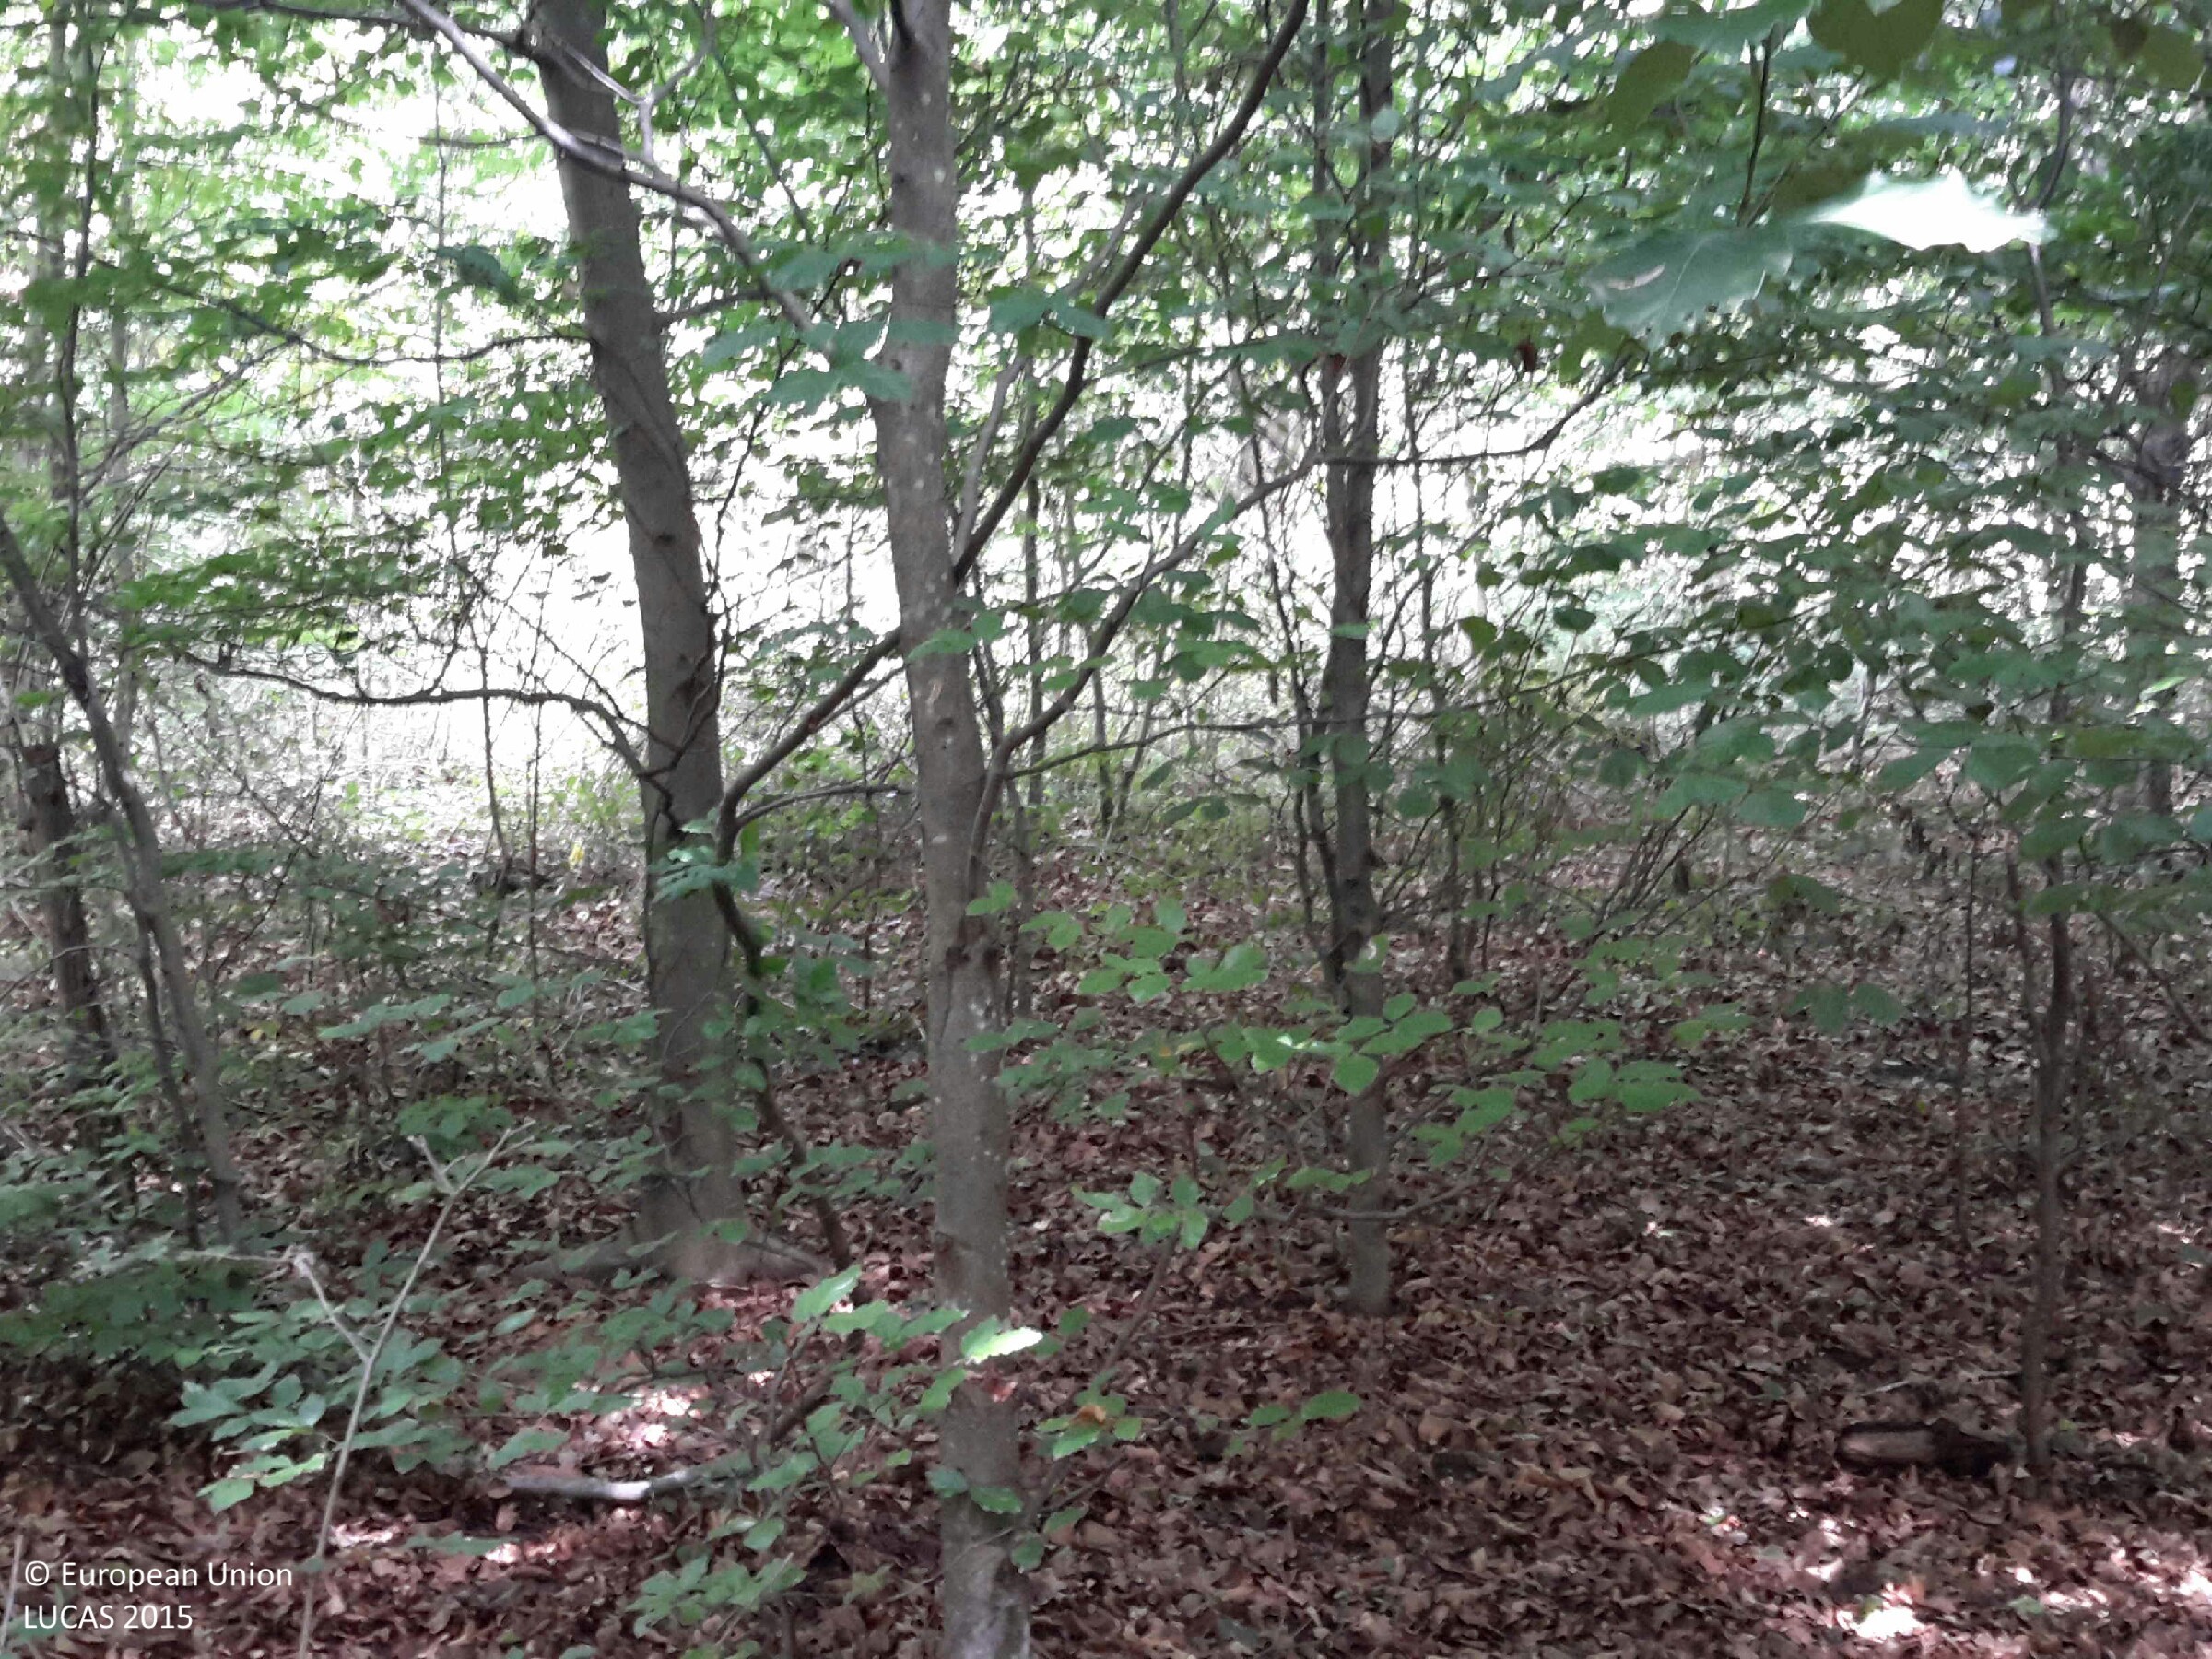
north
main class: Woodland
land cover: Broadleaved woodland
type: beech forest
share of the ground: > 75 %
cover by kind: broadleaved forest trees 100 %
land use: Forestry
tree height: > 5 m
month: July
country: HU
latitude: 47.1810
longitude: 16.5350
